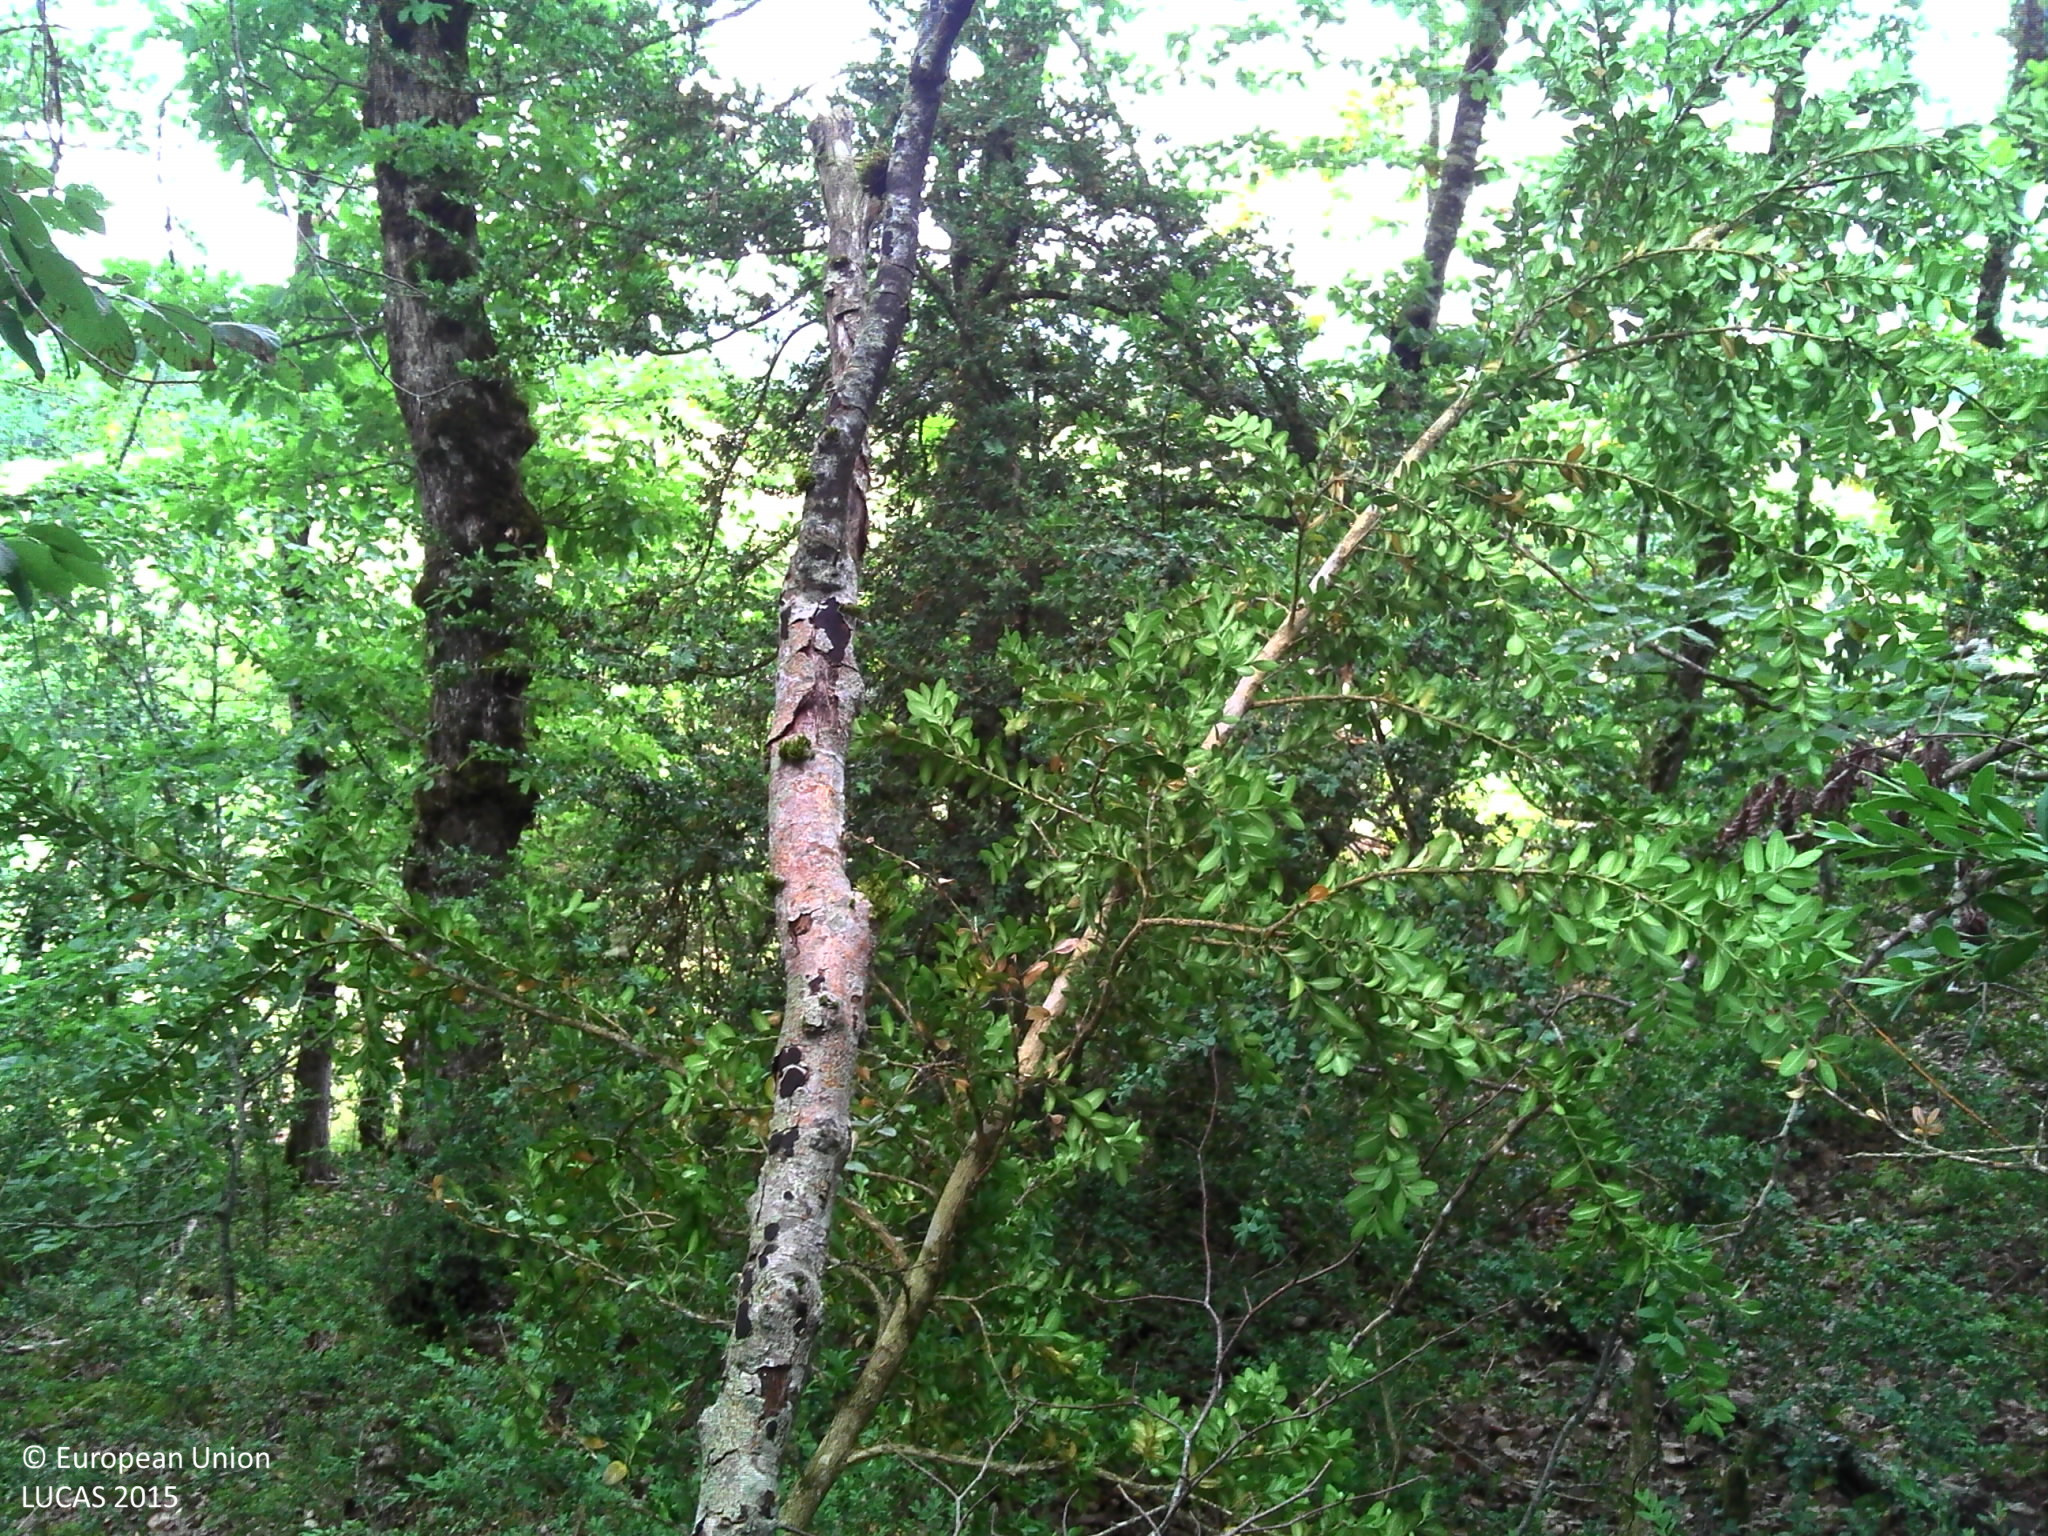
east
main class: Woodland
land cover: Broadleaved woodland
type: acidophilous oak and oak-birch forest
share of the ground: > 75 %
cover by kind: broadleaved forest trees 80 %, shrubs 10 %, herbaceous plants 5 %, lichens and mosses 5 %
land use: Forestry
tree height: > 5 m
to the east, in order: Broadleaved woodland; Lucerne; Shrubland without tree cover; Lucerne; Broadleaved woodland
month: July
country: FR
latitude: 44.4189
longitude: 2.9583
